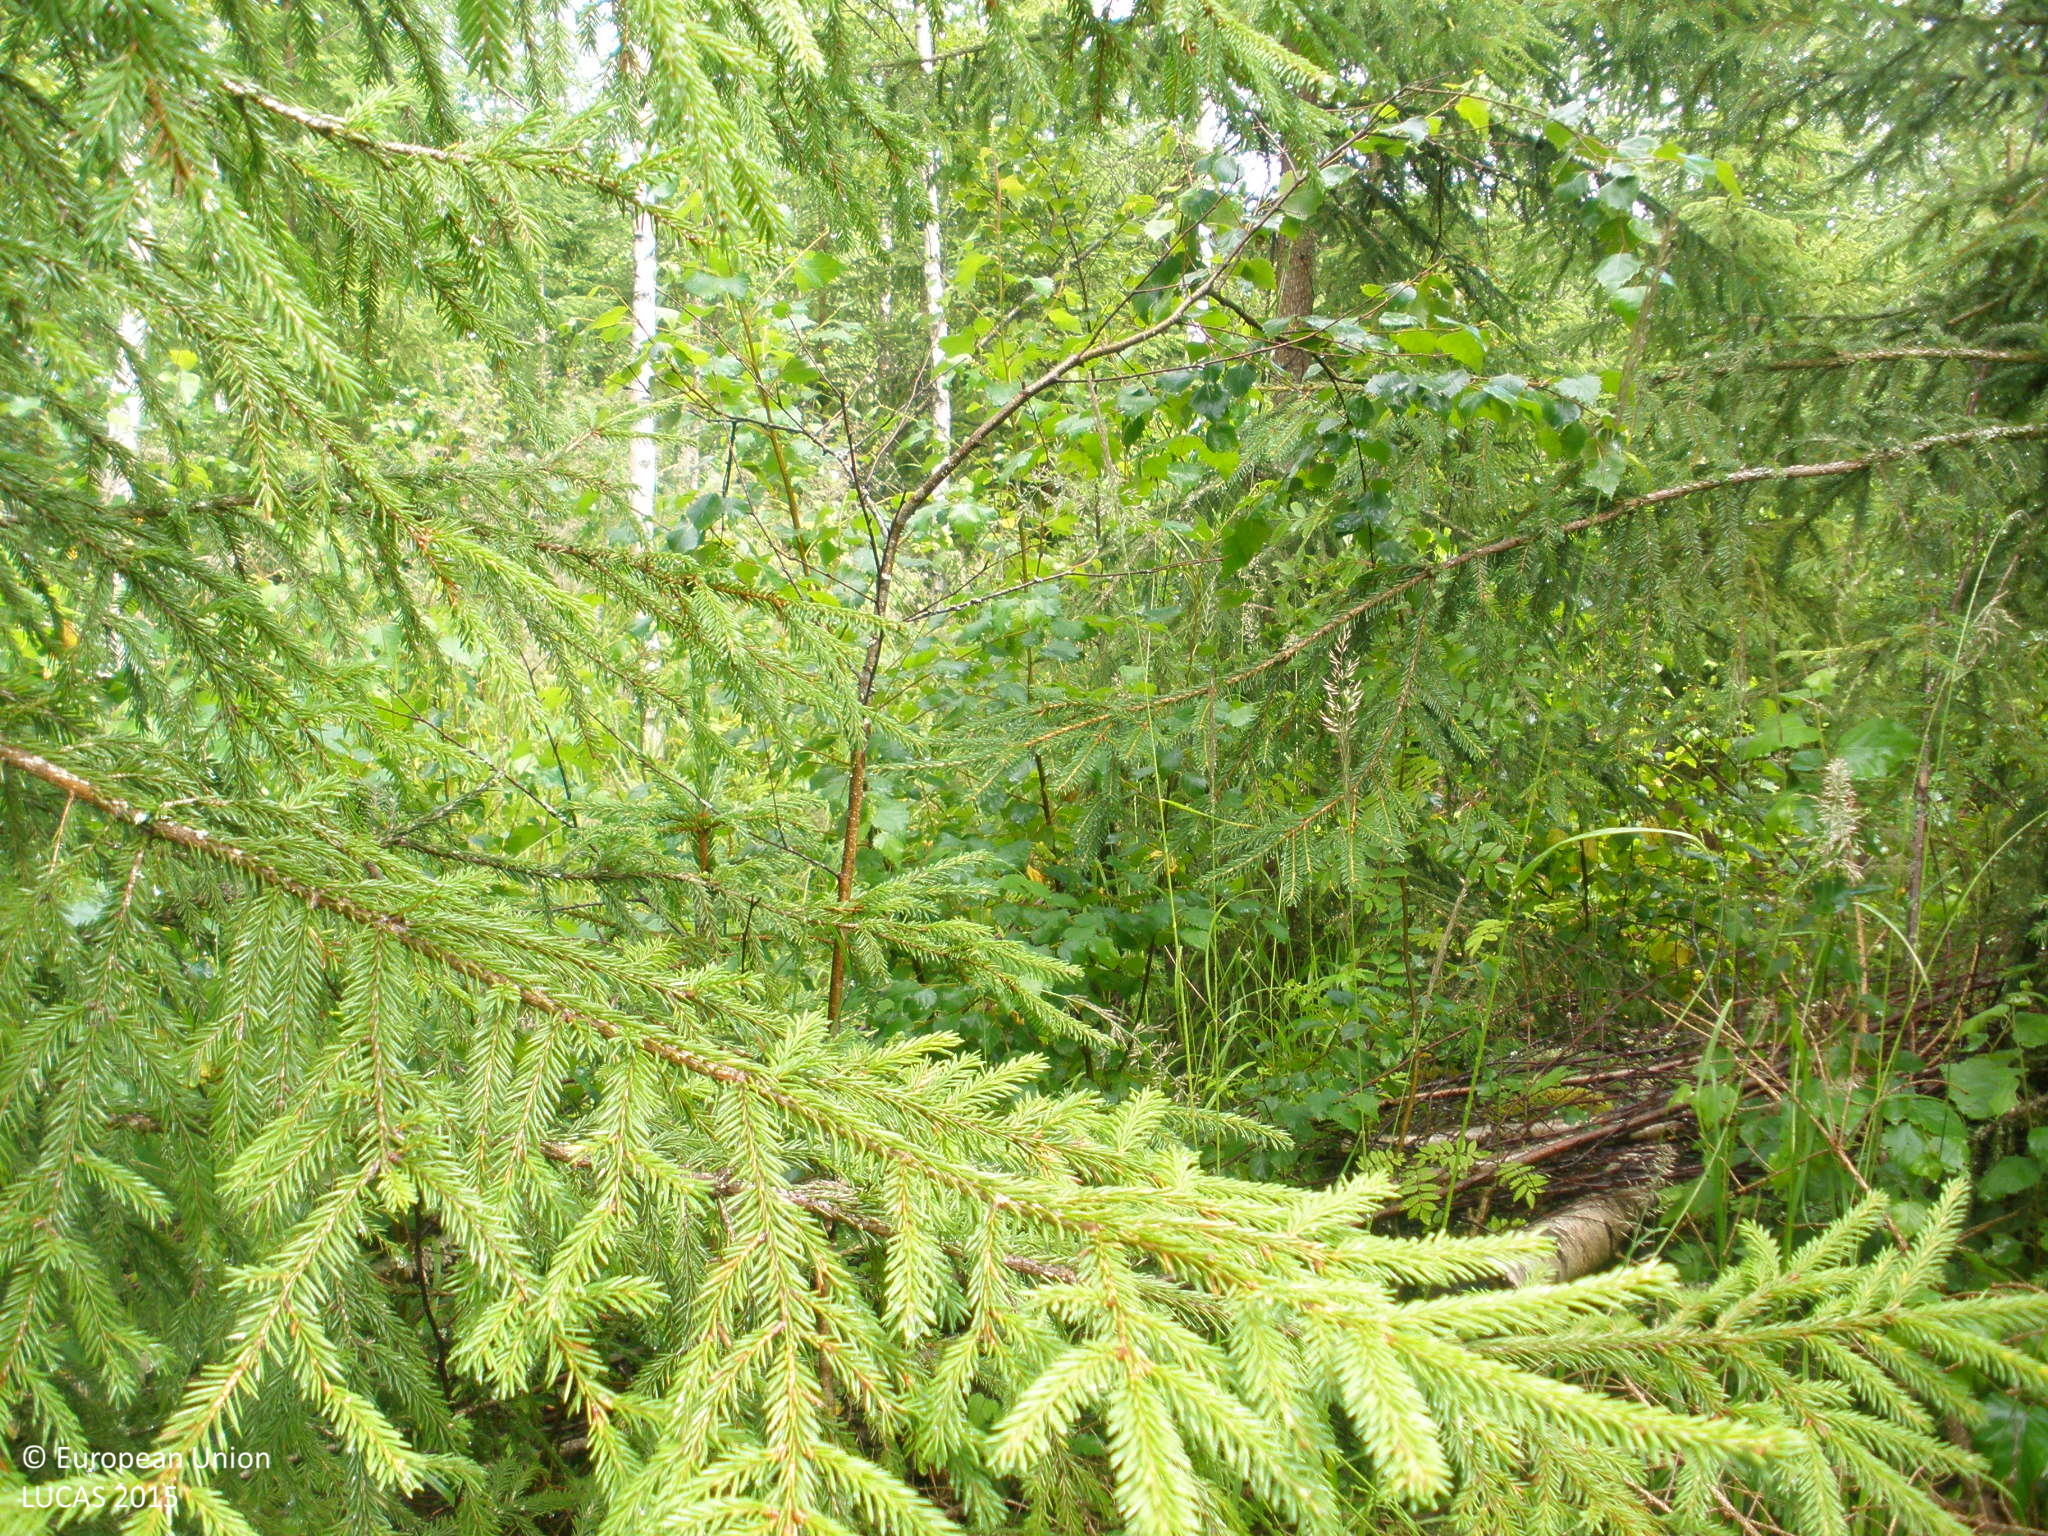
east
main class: Woodland
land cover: Spruce dominated mixed woodland
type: boreal forest
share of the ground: > 75 %
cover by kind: coniferous forest trees 50 %, broadleaved forest trees 25 %, herbaceous plants 15 %, shrubs 10 %
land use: Forestry
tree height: > 5 m
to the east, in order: Spruce dominated mixed woodland; Ditches and canals; Shrubland with sparse tree cover; Tracks; Spruce dominated mixed woodland; Other mixed woodland
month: July
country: FI
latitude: 61.2295
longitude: 24.9931
